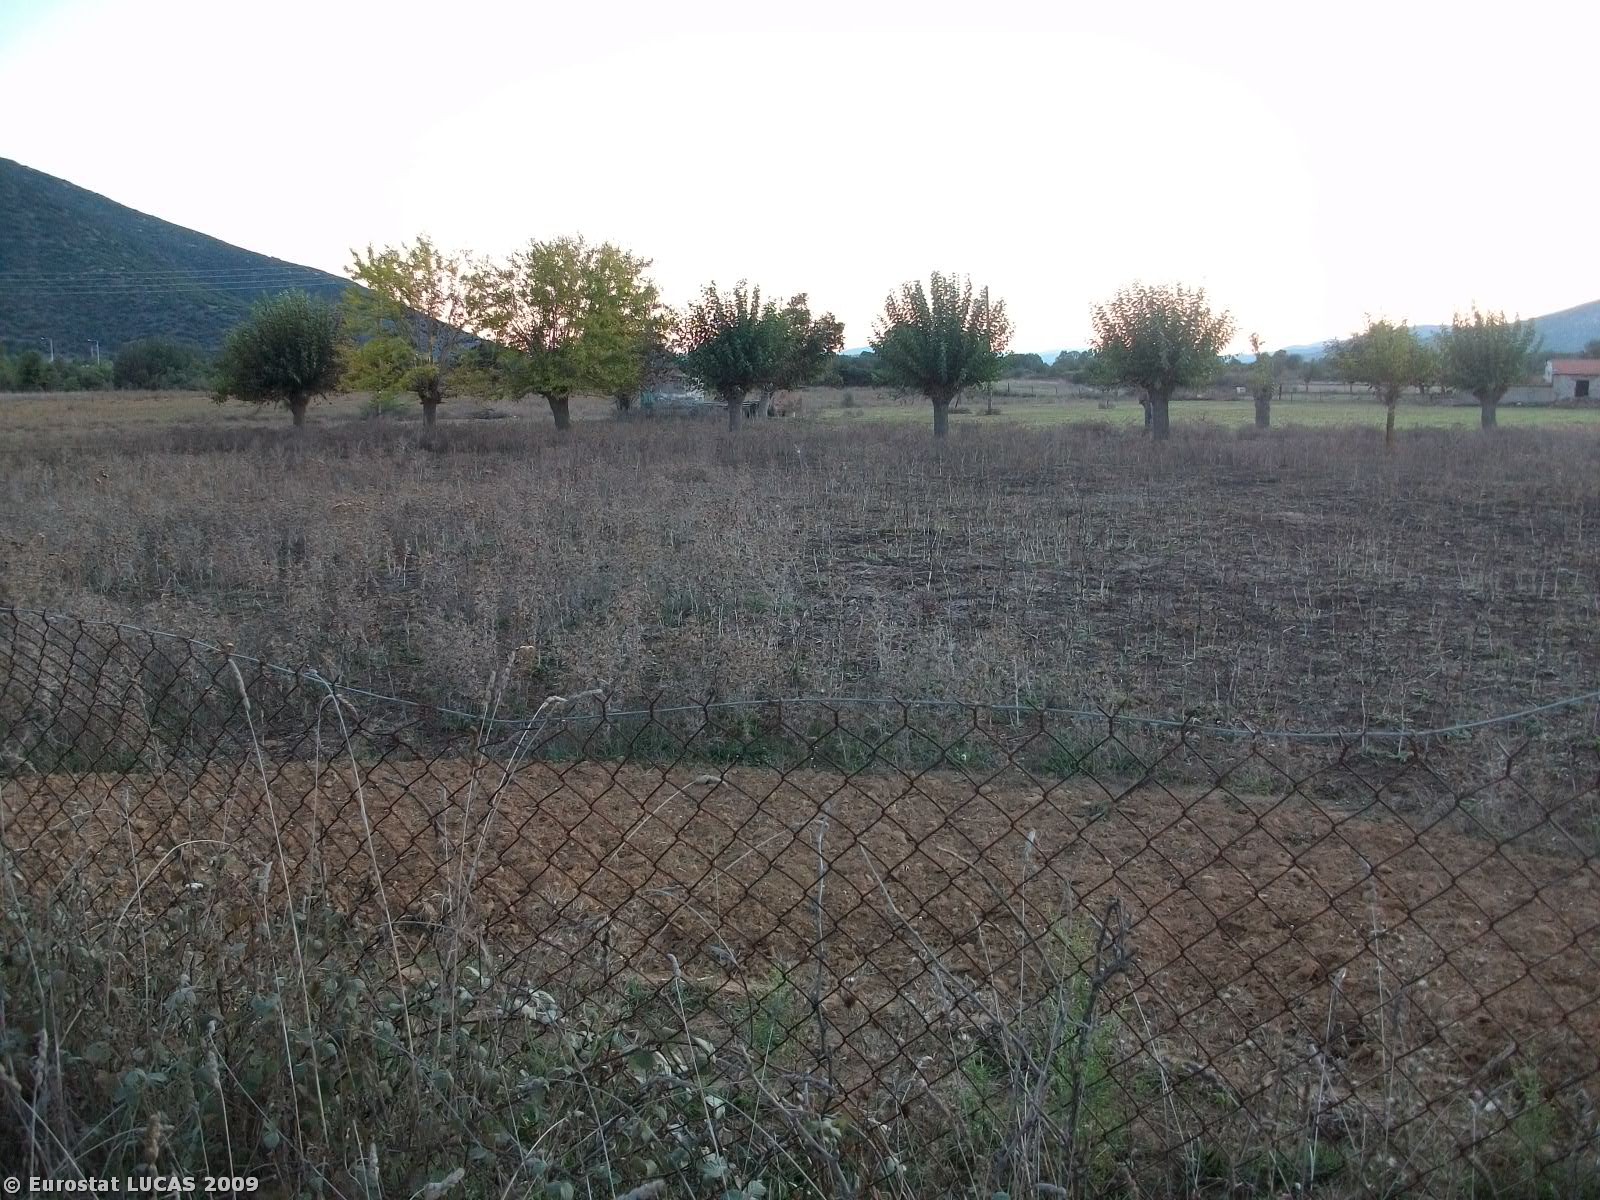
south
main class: Grassland
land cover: Spontaneously vegetated surfaces
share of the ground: > 75 %
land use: Fallow land
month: October
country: GR
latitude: 37.5881
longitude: 22.4320
